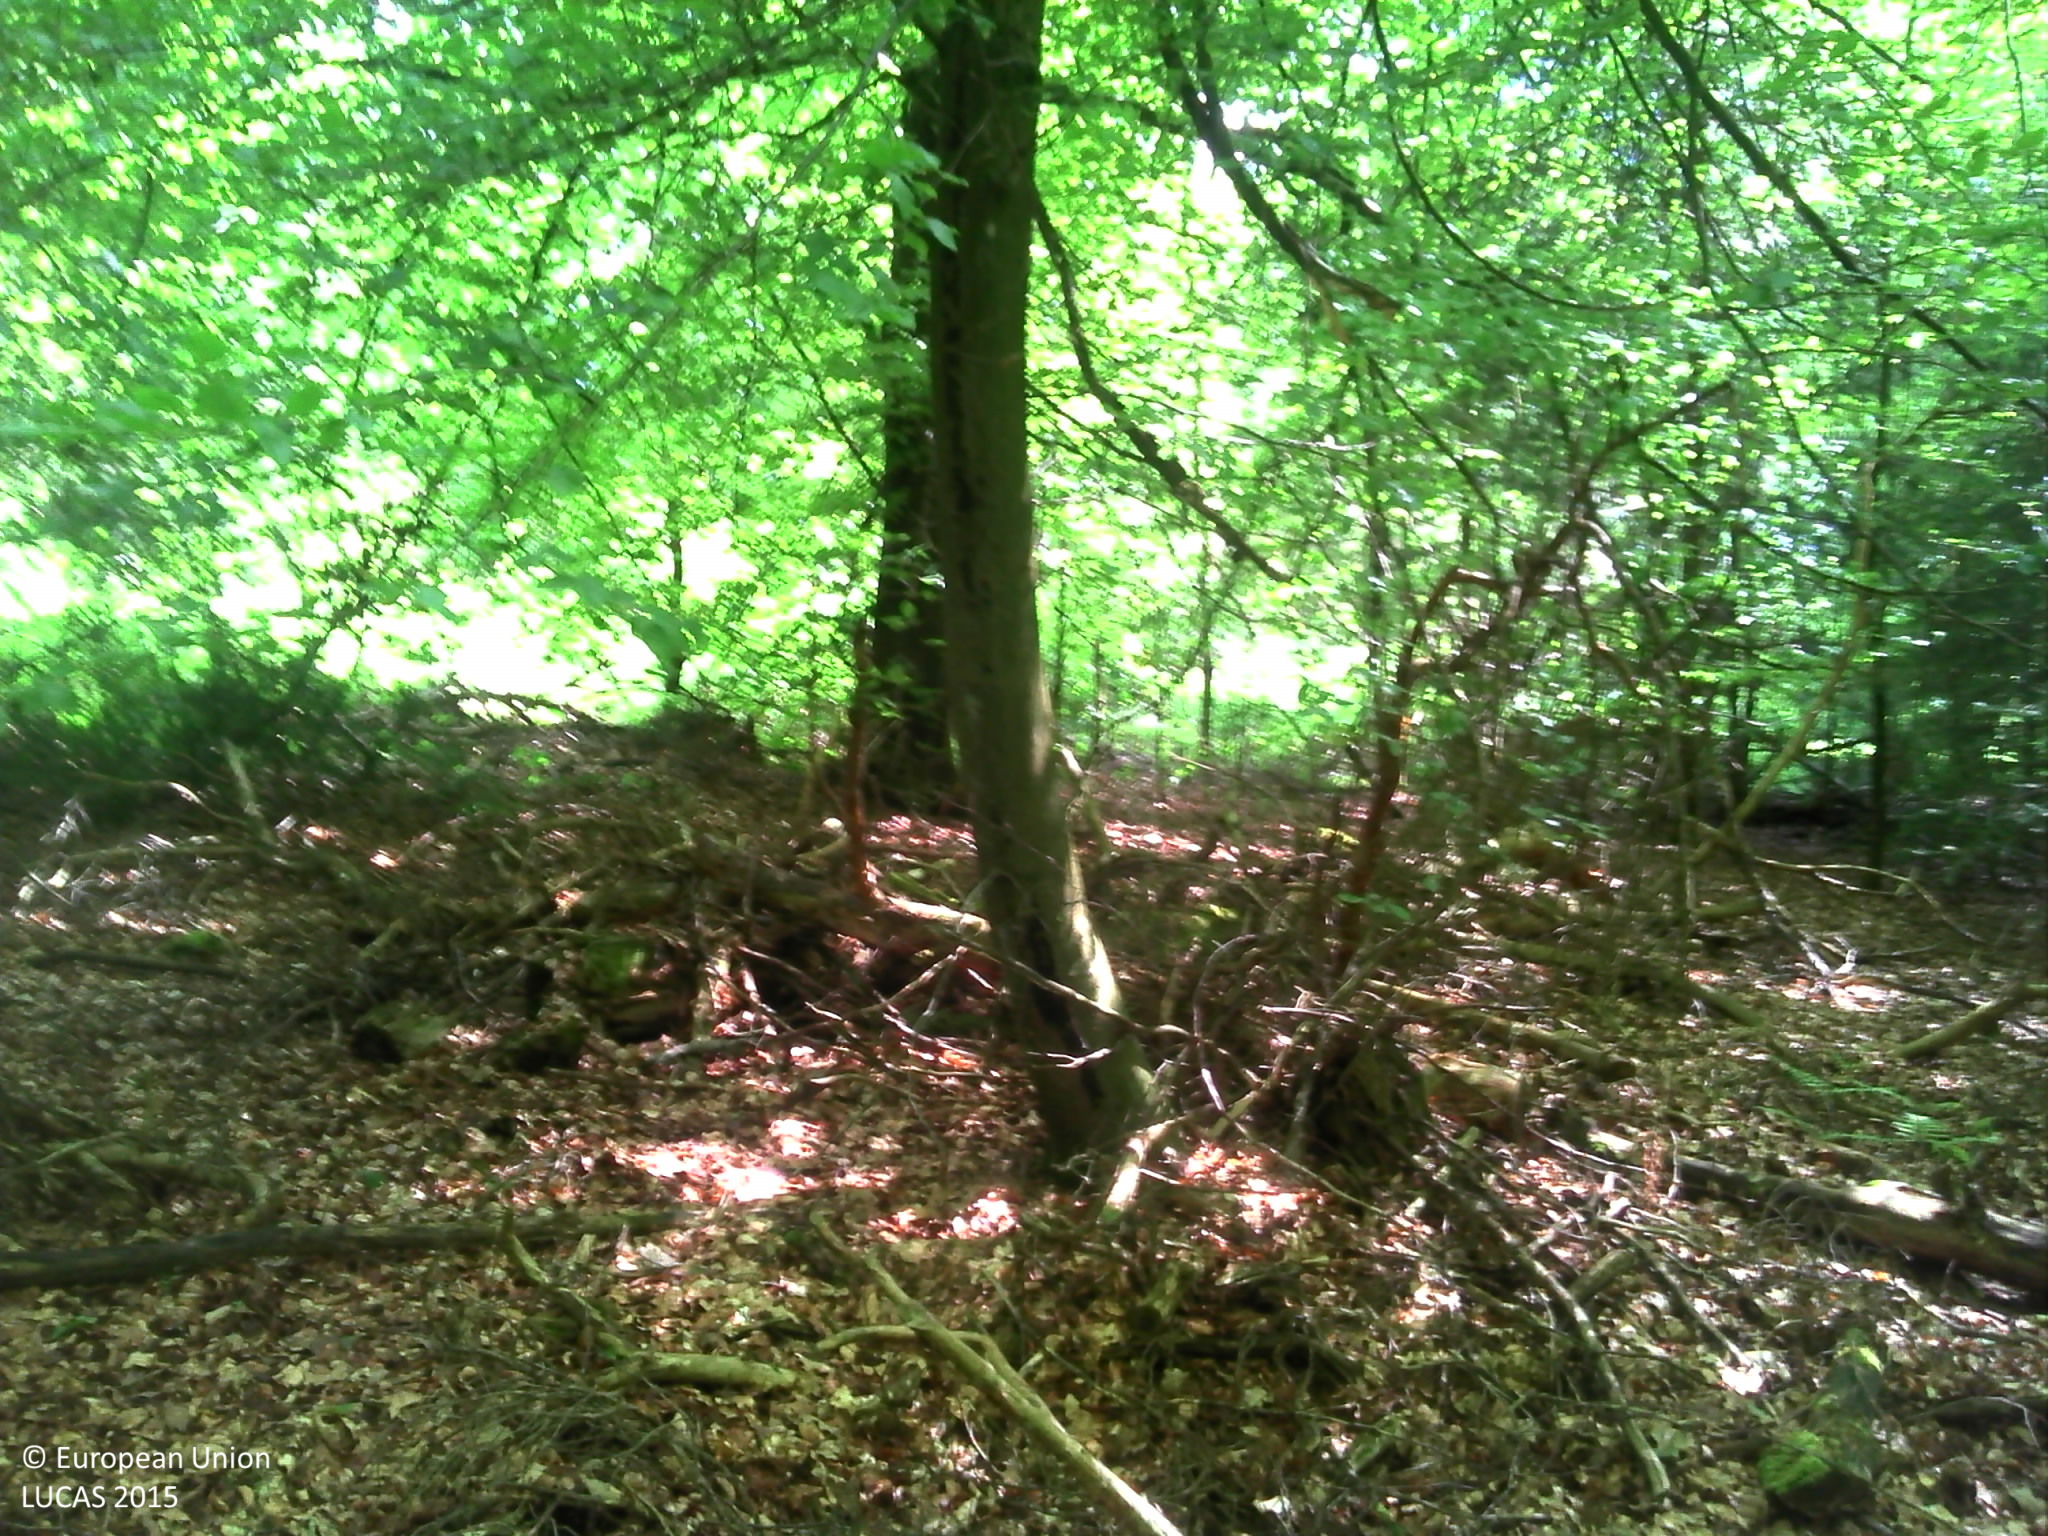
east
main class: Woodland
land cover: Broadleaved woodland
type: acidophilous oak and oak-birch forest
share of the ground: > 75 %
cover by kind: broadleaved forest trees 90 %, coniferous forest trees 5 %, herbaceous plants 5 %
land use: Forestry
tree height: > 5 m
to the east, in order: Broadleaved woodland; Grass margins; Paved roads, cycling and walking lanes; Grass margins; Ditches and canals; Grass margins; Other mixed woodland; Broadleaved woodland; Ditches and canals; Broadleaved woodland; Tracks; Broadleaved woodland
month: May
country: LU
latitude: 49.8424
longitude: 5.9526
